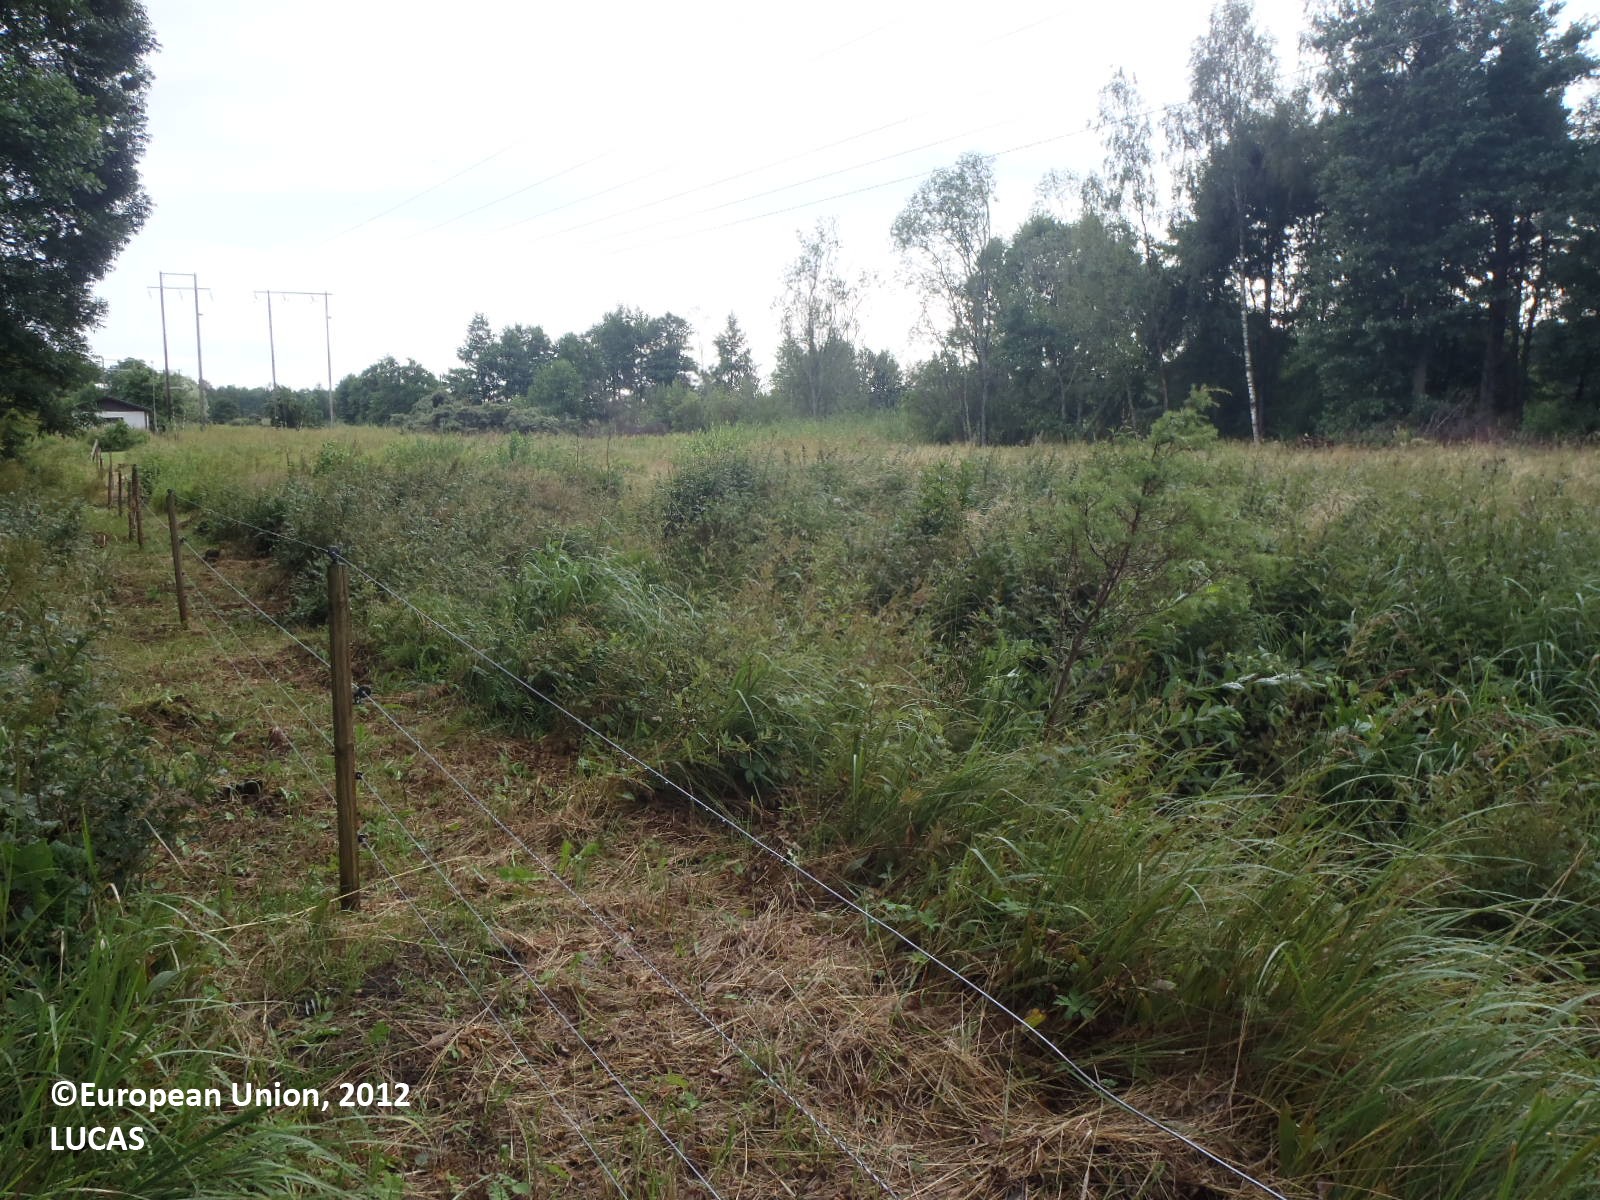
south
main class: Woodland
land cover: Broadleaved woodland
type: hemiboreal forest and nemoral coniferous forest and mixed broadleaved-coniferous forest
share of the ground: > 75 %
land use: Agriculture (excluding fallow land and kitchen gardens)
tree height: > 5 m
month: August
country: FI
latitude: 60.1208
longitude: 19.9223
